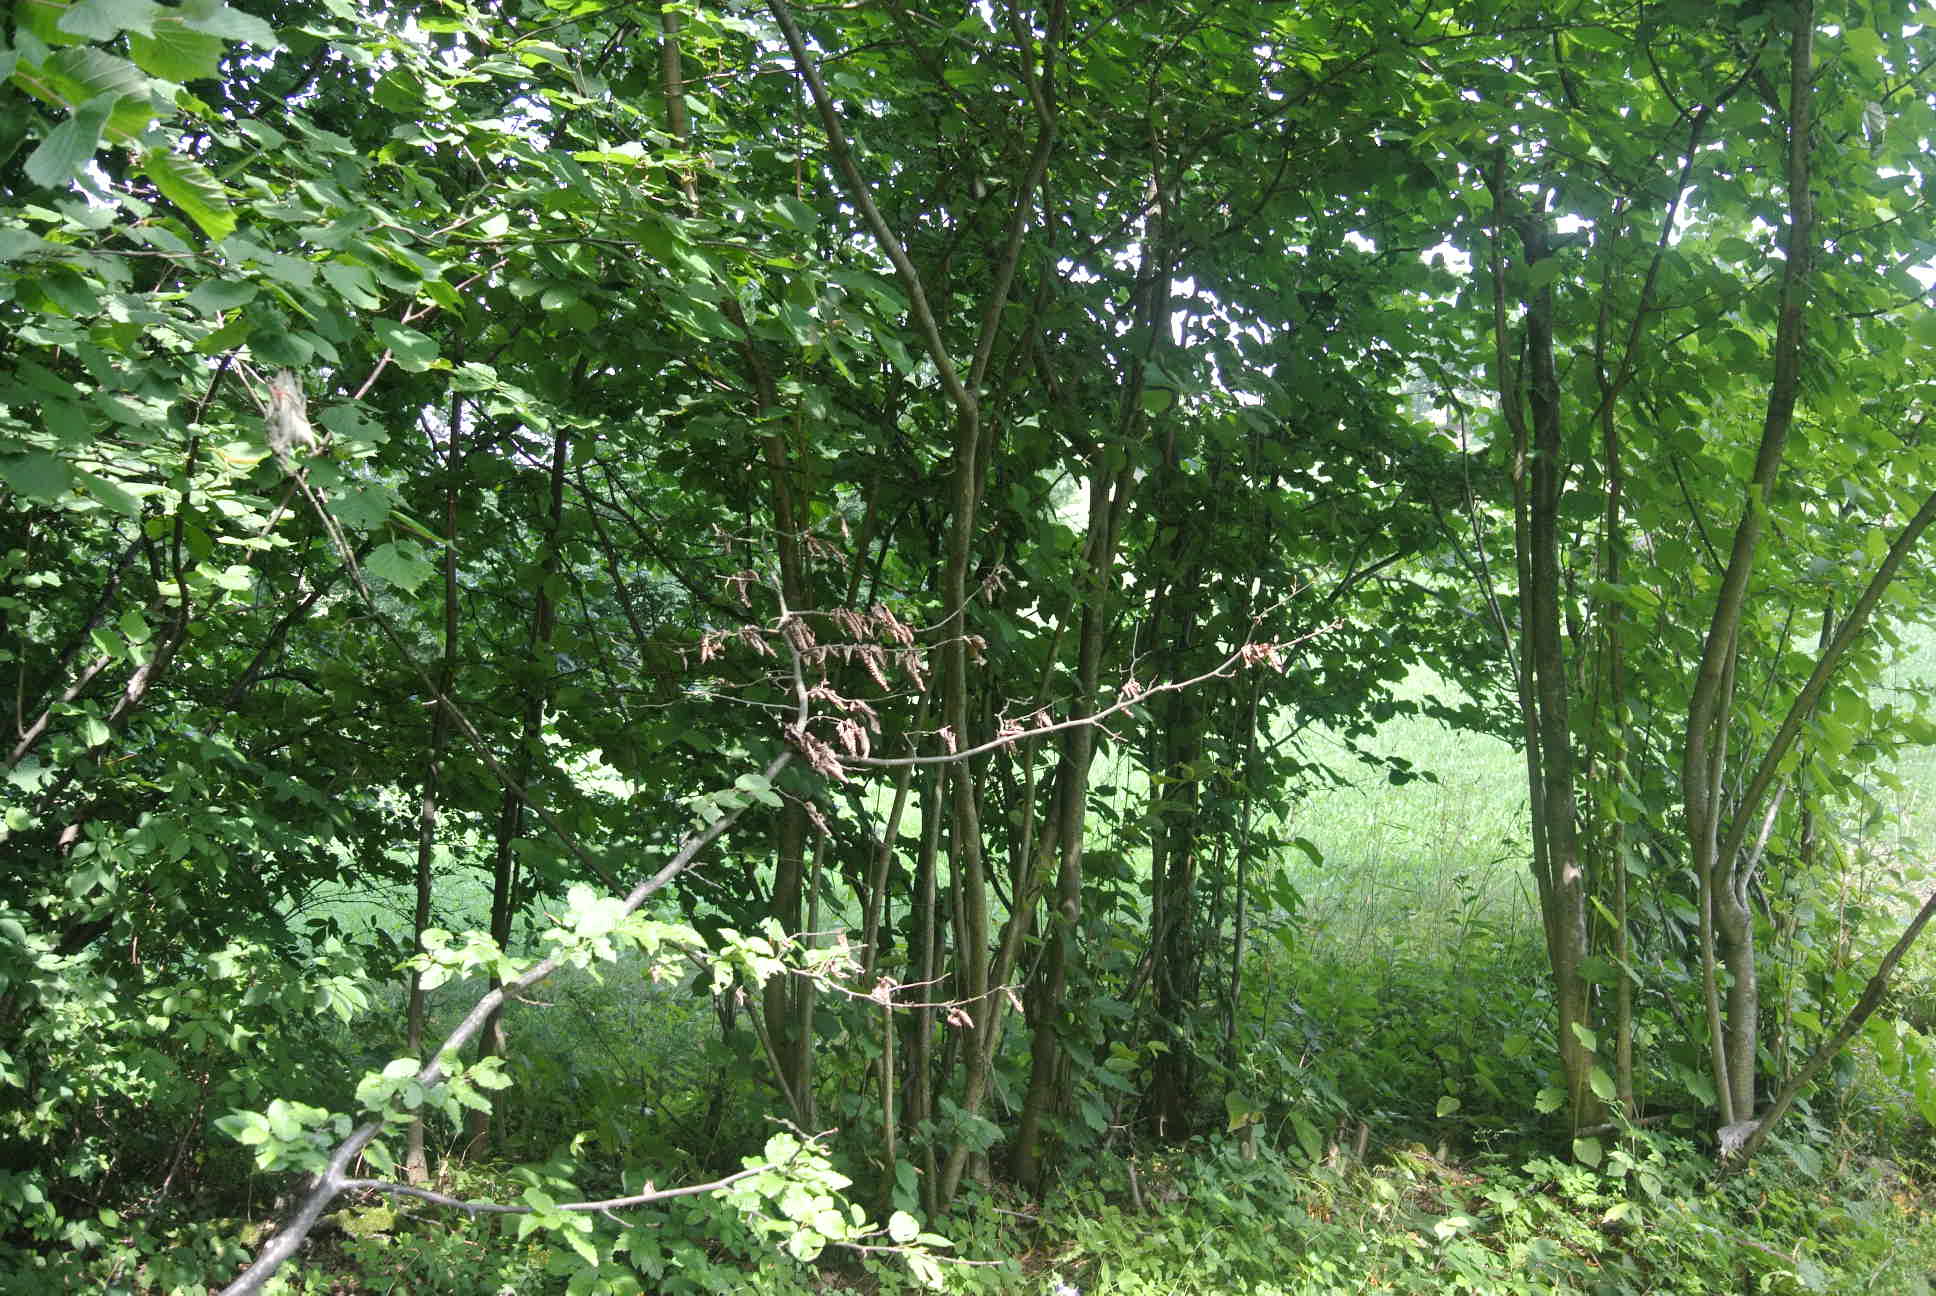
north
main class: Woodland
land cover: Spruce dominated mixed woodland
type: alpine coniferous forest
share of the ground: > 75 %
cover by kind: coniferous forest trees 60 %, broadleaved forest trees 40 %
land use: Forestry
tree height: > 5 m
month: July
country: AT
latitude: 48.0162
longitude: 15.4584
